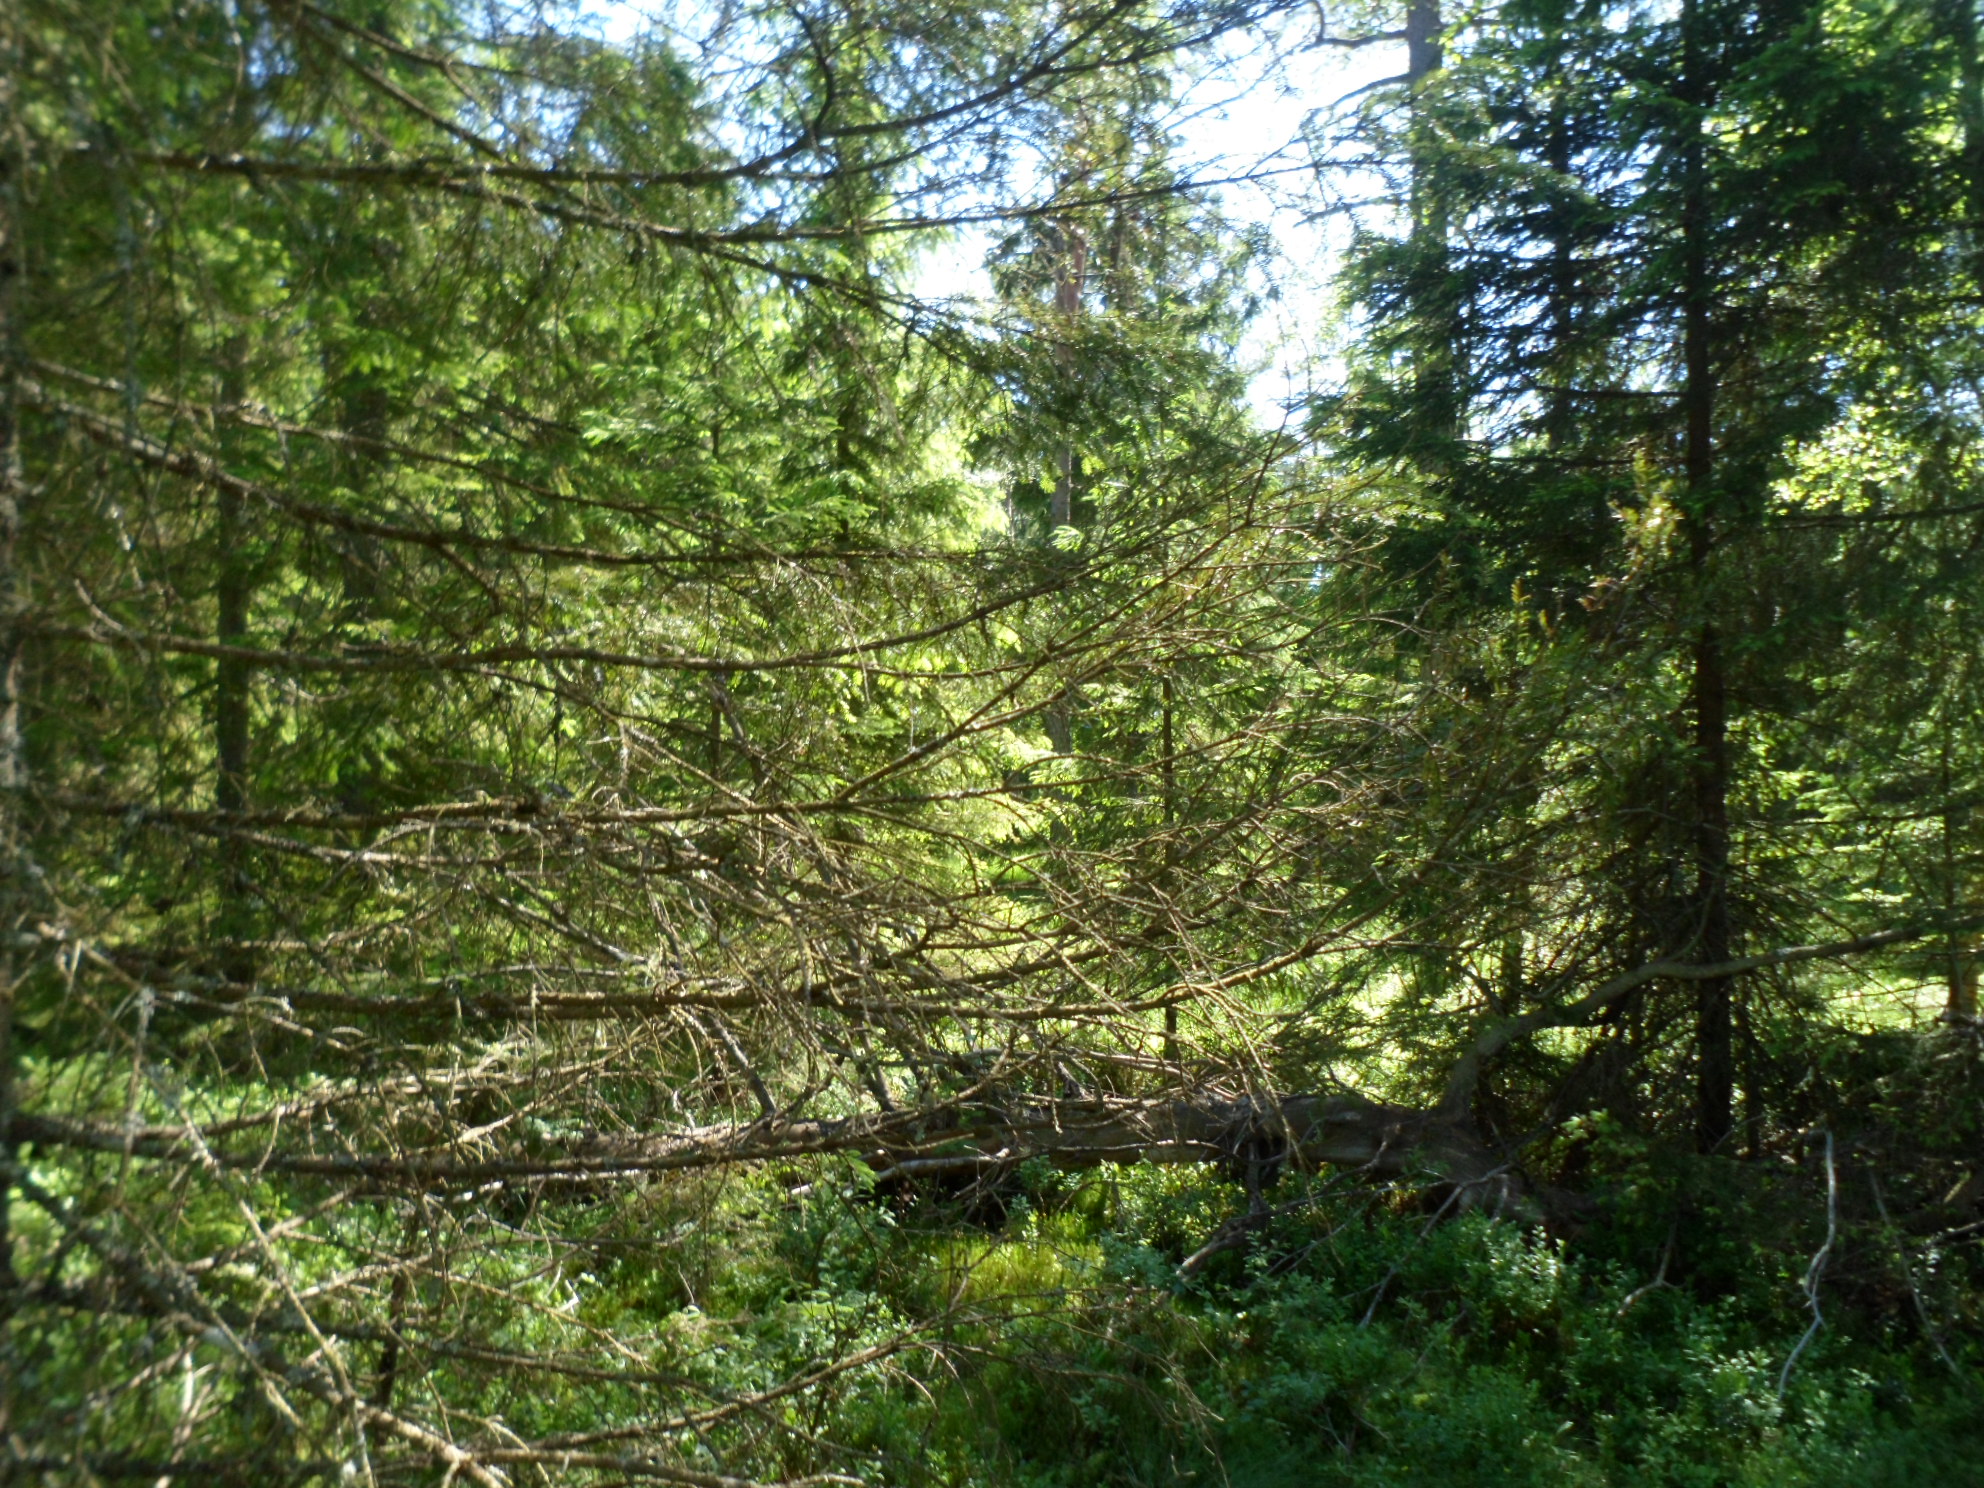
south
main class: Woodland
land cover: Spruce dominated coniferous woodland
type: boreal forest
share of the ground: 50 - 75 %
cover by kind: coniferous forest trees 50 %, shrubs 30 %, lichens and mosses 10 %, broadleaved forest trees 5 %, herbaceous plants 5 %
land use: Forestry
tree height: > 5 m
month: July
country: SE
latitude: 57.4940
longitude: 14.5506
